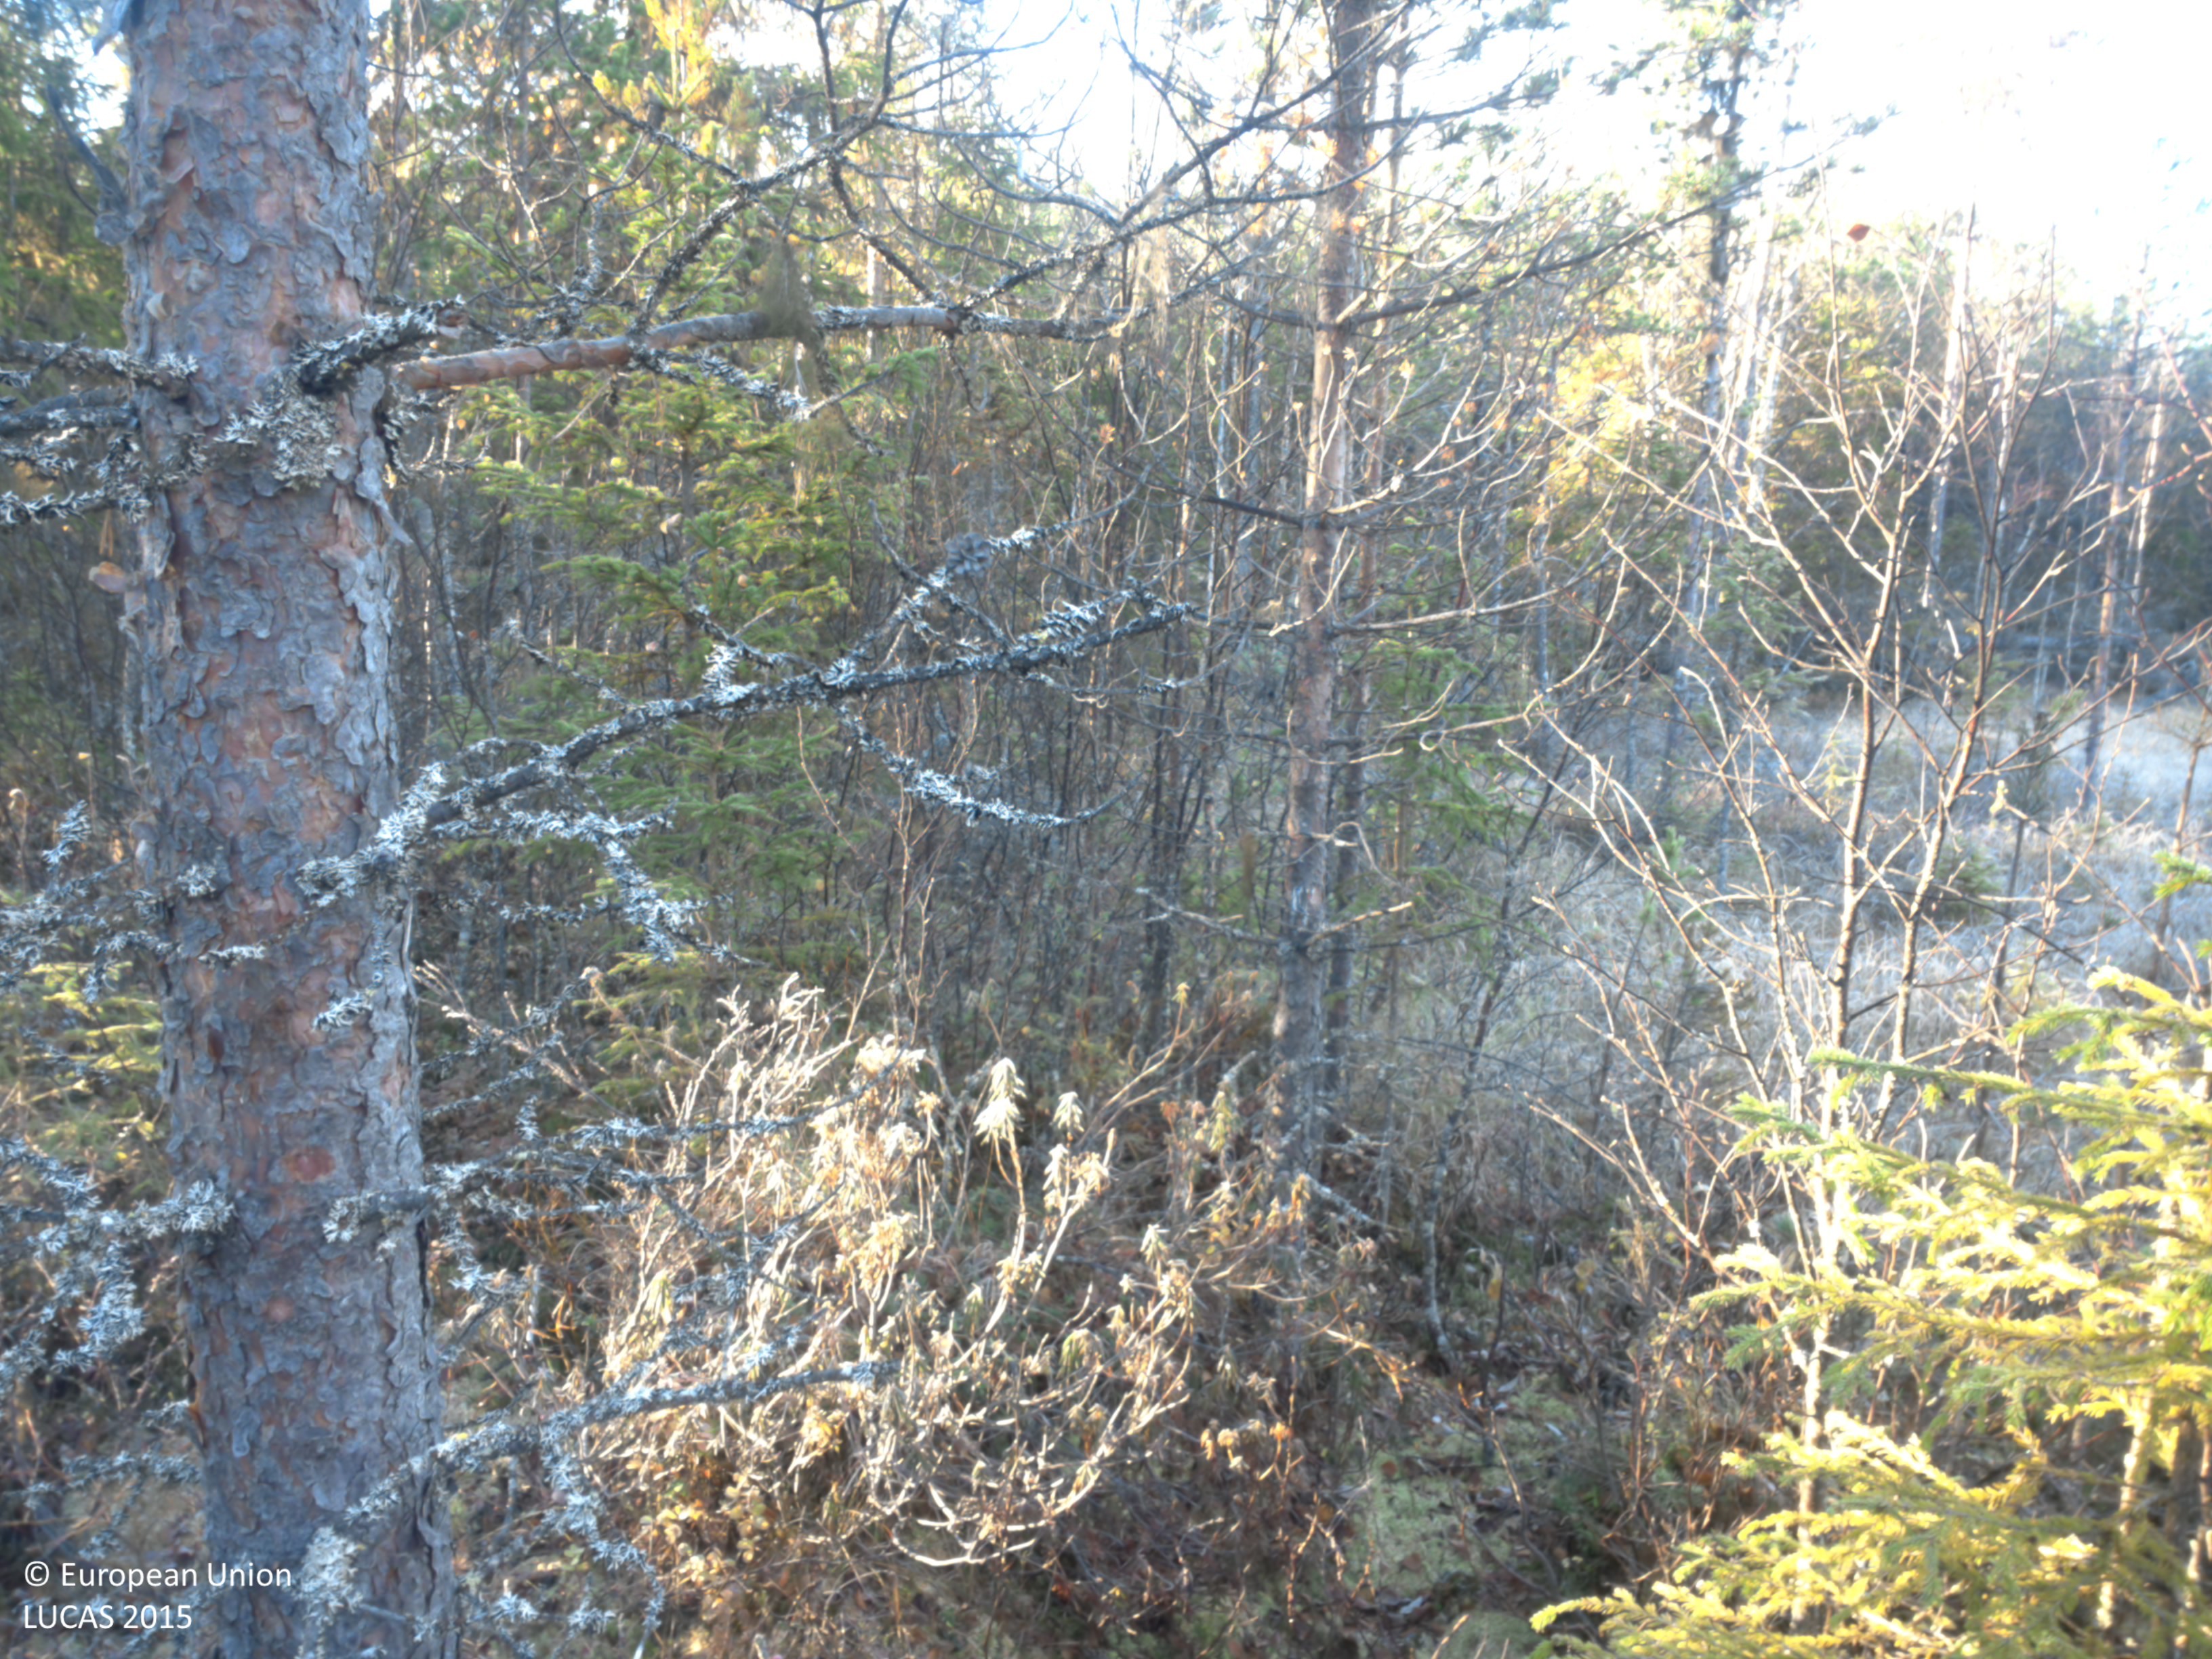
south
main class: Woodland
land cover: Pine dominated mixed woodland
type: boreal forest
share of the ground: 25 - 50 %
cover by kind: coniferous forest trees 30 %, shrubs 25 %, herbaceous plants 25 %, broadleaved forest trees 10 %, lichens and mosses 10 %
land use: Forestry
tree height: < 5 m
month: October
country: SE
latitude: 64.8019
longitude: 18.2385
